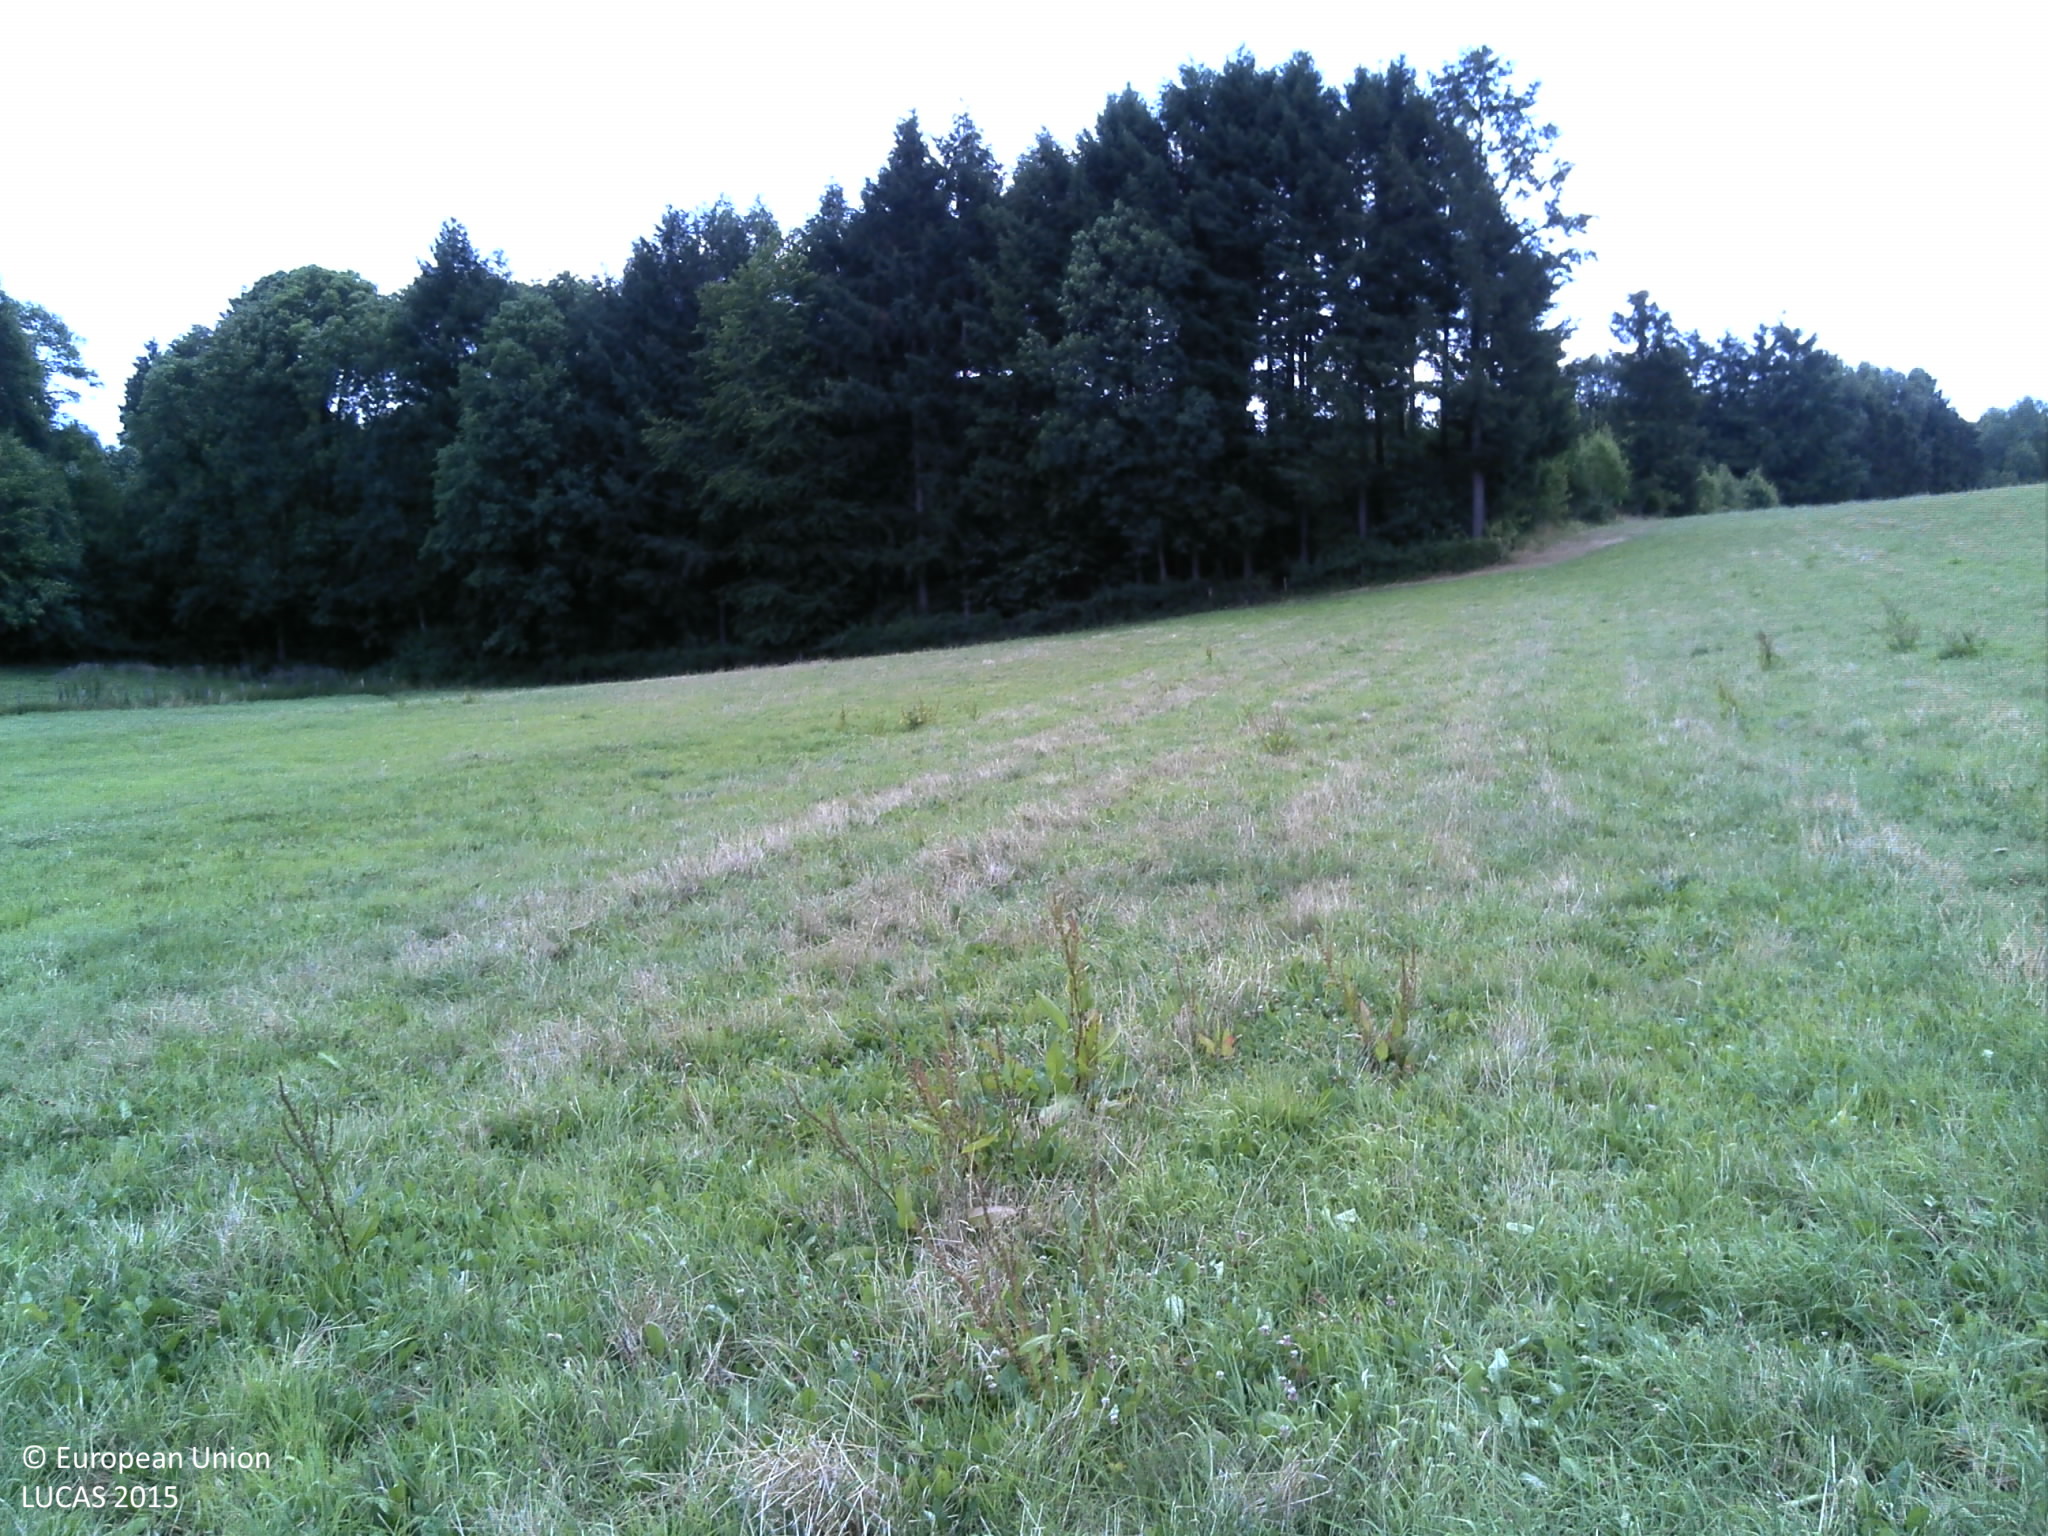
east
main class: Grassland
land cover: Grassland without tree/shrub cover
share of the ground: > 75 %
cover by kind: herbaceous plants 100 %
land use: Agriculture (excluding fallow land and kitchen gardens)
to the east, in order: Grassland without tree/shrub cover; Fences; Spruce dominated mixed woodland; Broadleaved woodland
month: July
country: FR
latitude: 48.1625
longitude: 6.3302
